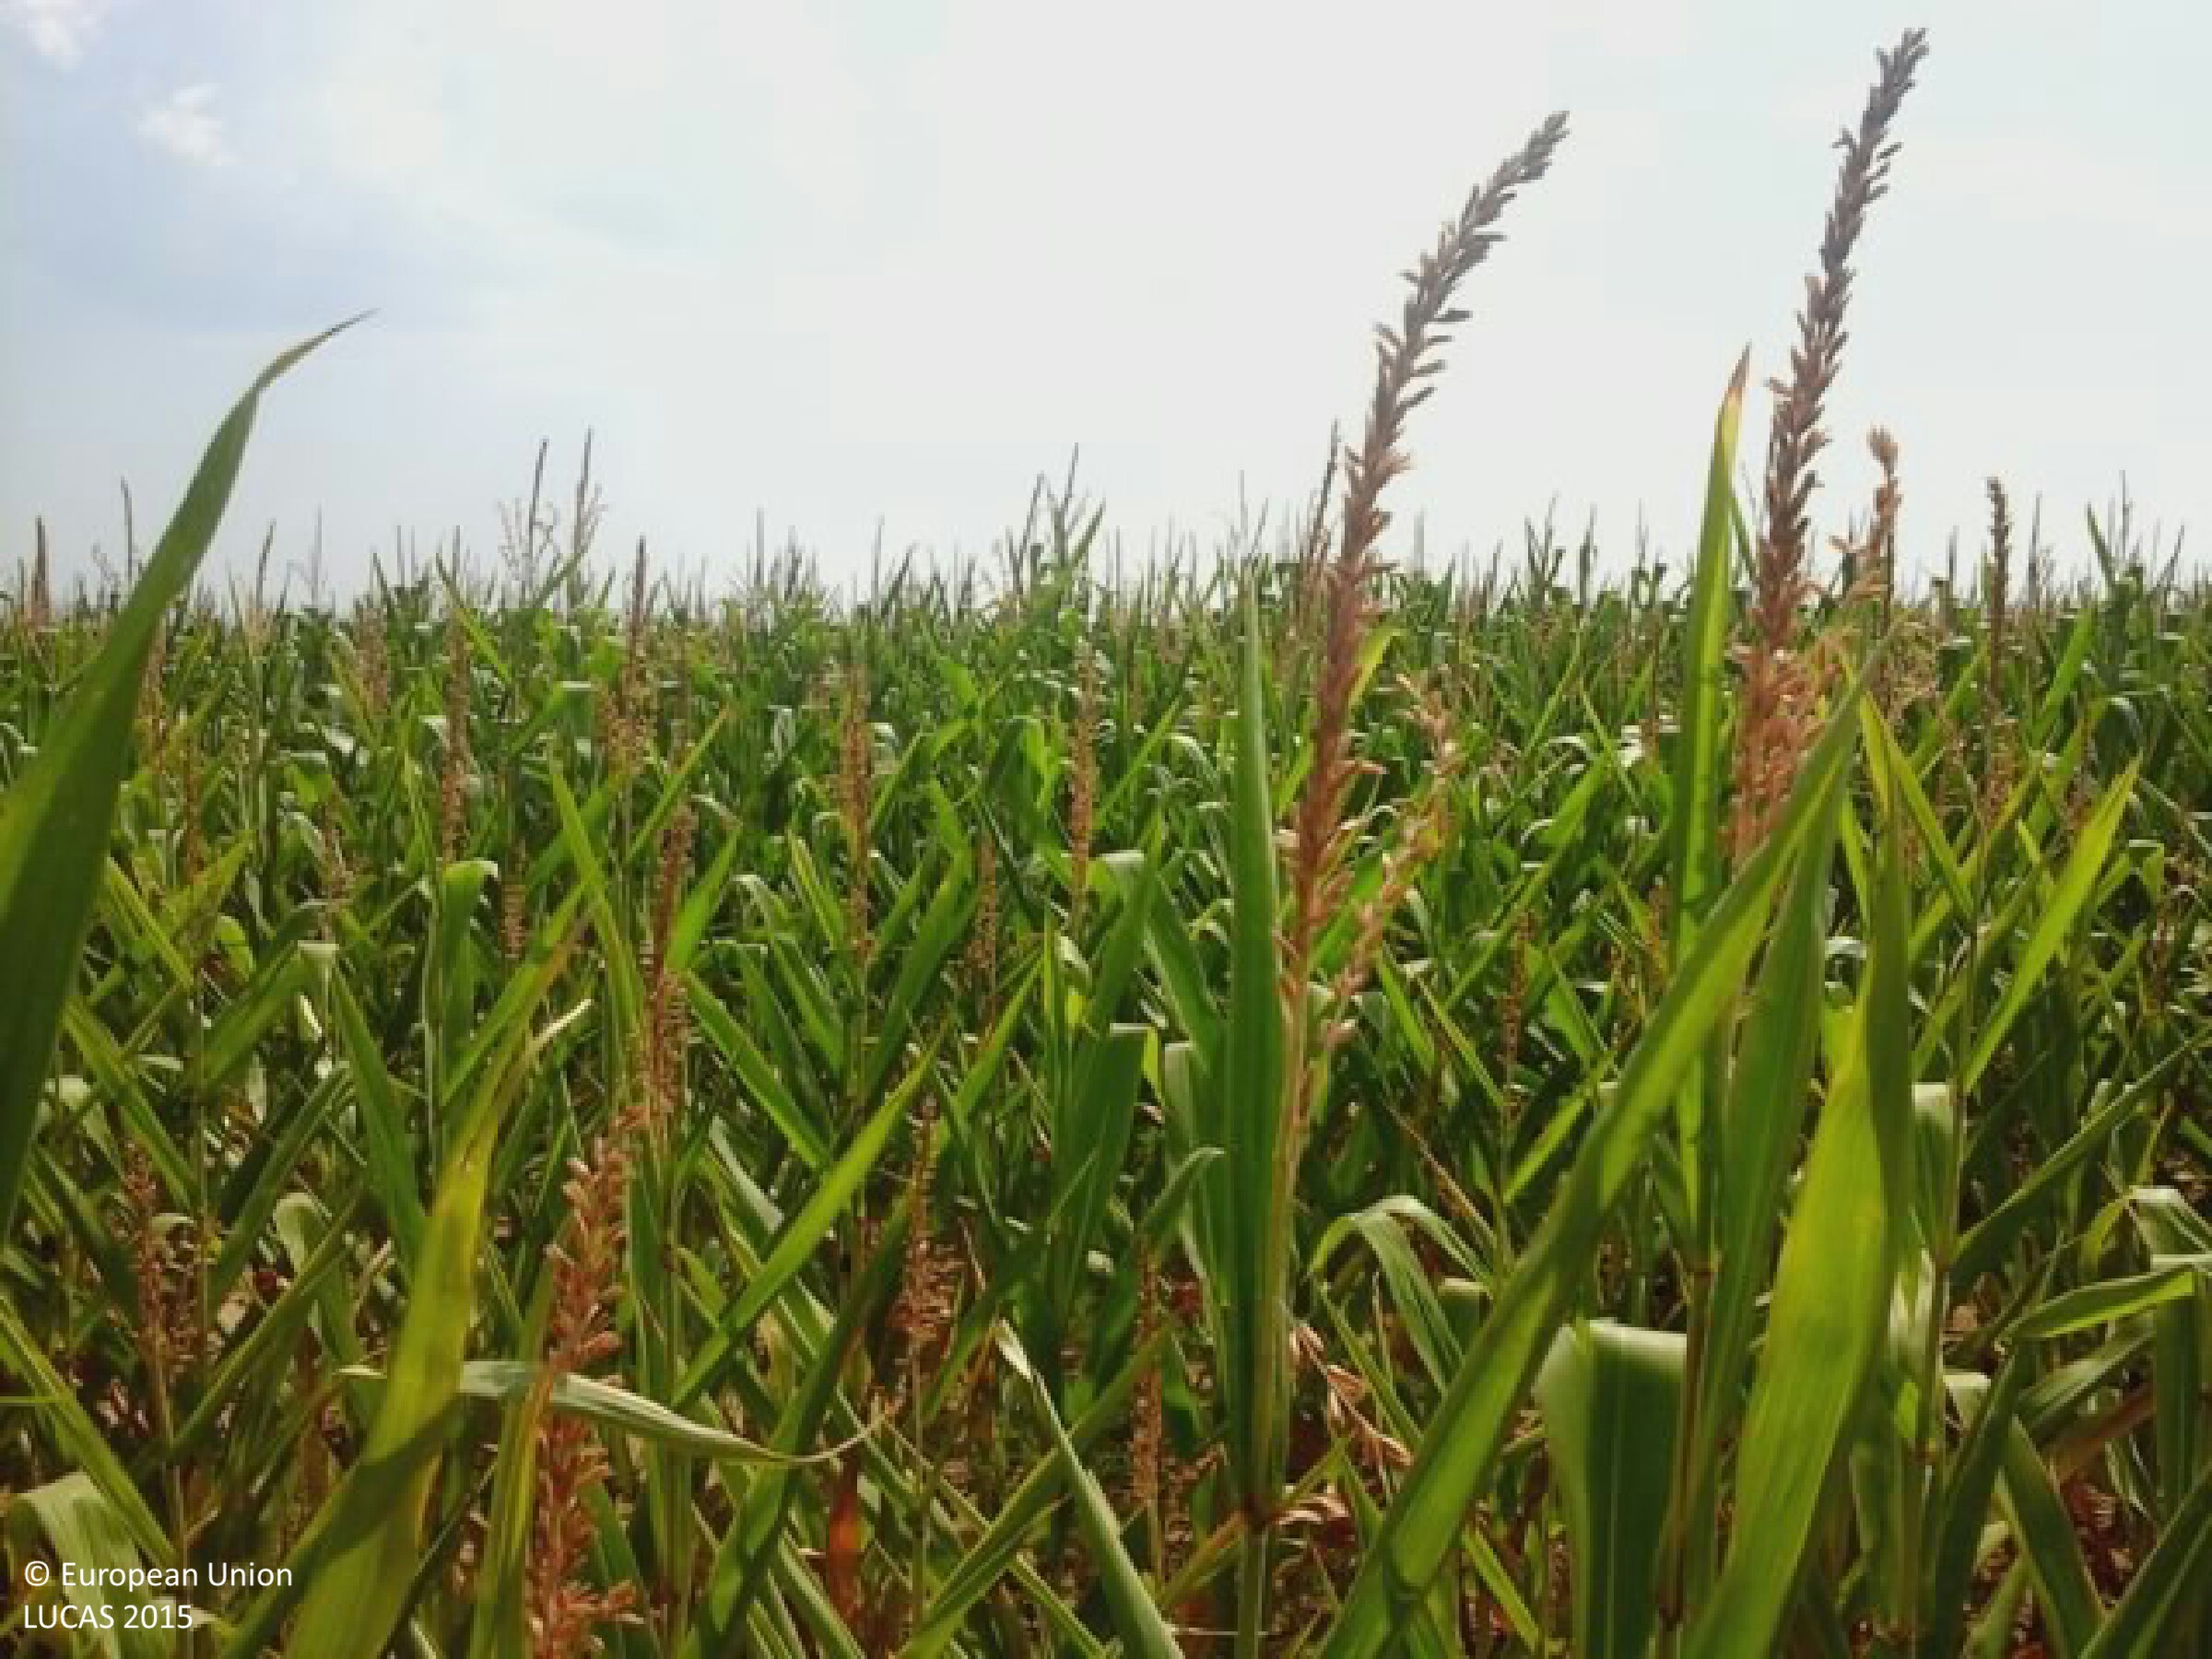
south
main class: Cropland
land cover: Maize
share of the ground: > 75 %
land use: Agriculture (excluding fallow land and kitchen gardens)
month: August
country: HU
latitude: 46.3571
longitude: 18.2610
